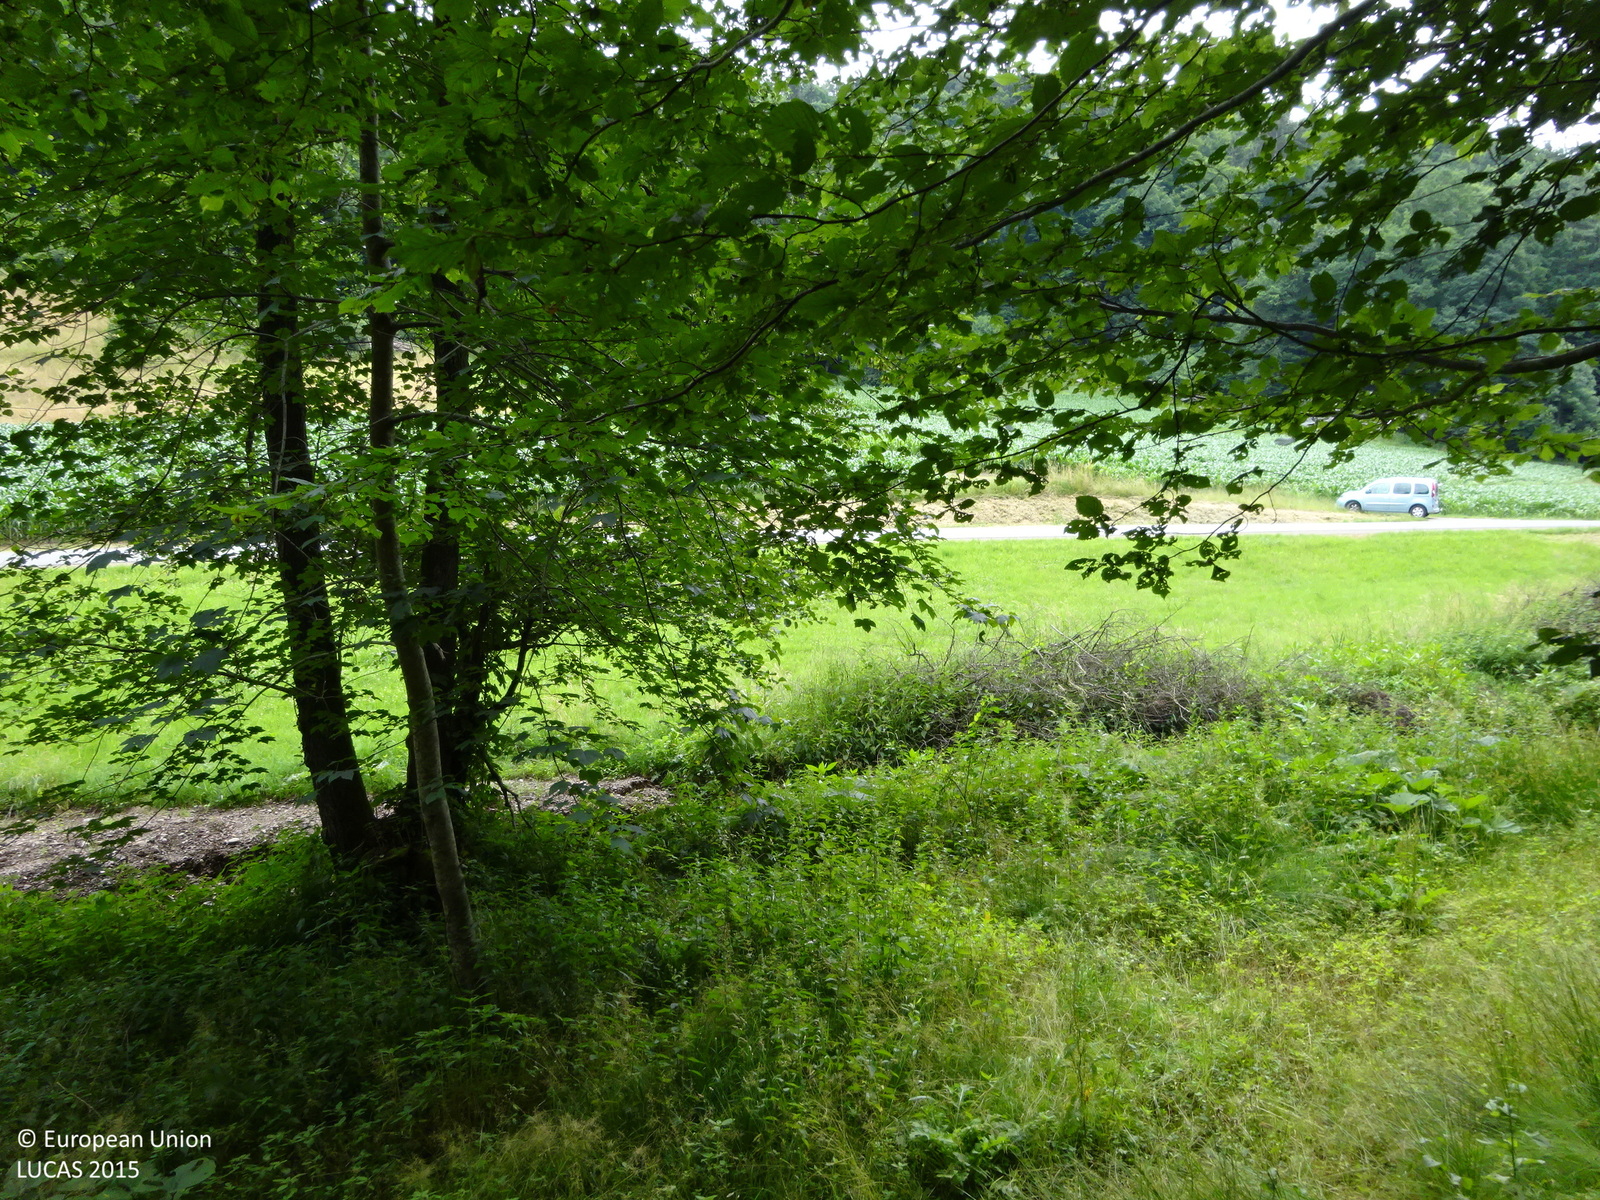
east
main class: Woodland
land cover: Spruce dominated mixed woodland
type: mountainous beech forest
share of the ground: > 75 %
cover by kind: broadleaved forest trees 75 %, coniferous forest trees 25 %
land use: Forestry
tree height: > 5 m
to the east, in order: Spruce dominated mixed woodland; Broadleaved woodland; Rivers and streams; Other bare soil; Grassland without tree/shrub cover; Paved roads, cycling and walking lanes; Ditches and canals; Grass margins; Maize; Grass margins; Tracks; Maize; Grass margins; Maize; Grass margins; Broadleaved woodland; Shrubland with sparse tree cover; Broadleaved woodland
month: June
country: AT
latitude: 46.7533
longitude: 15.4582
